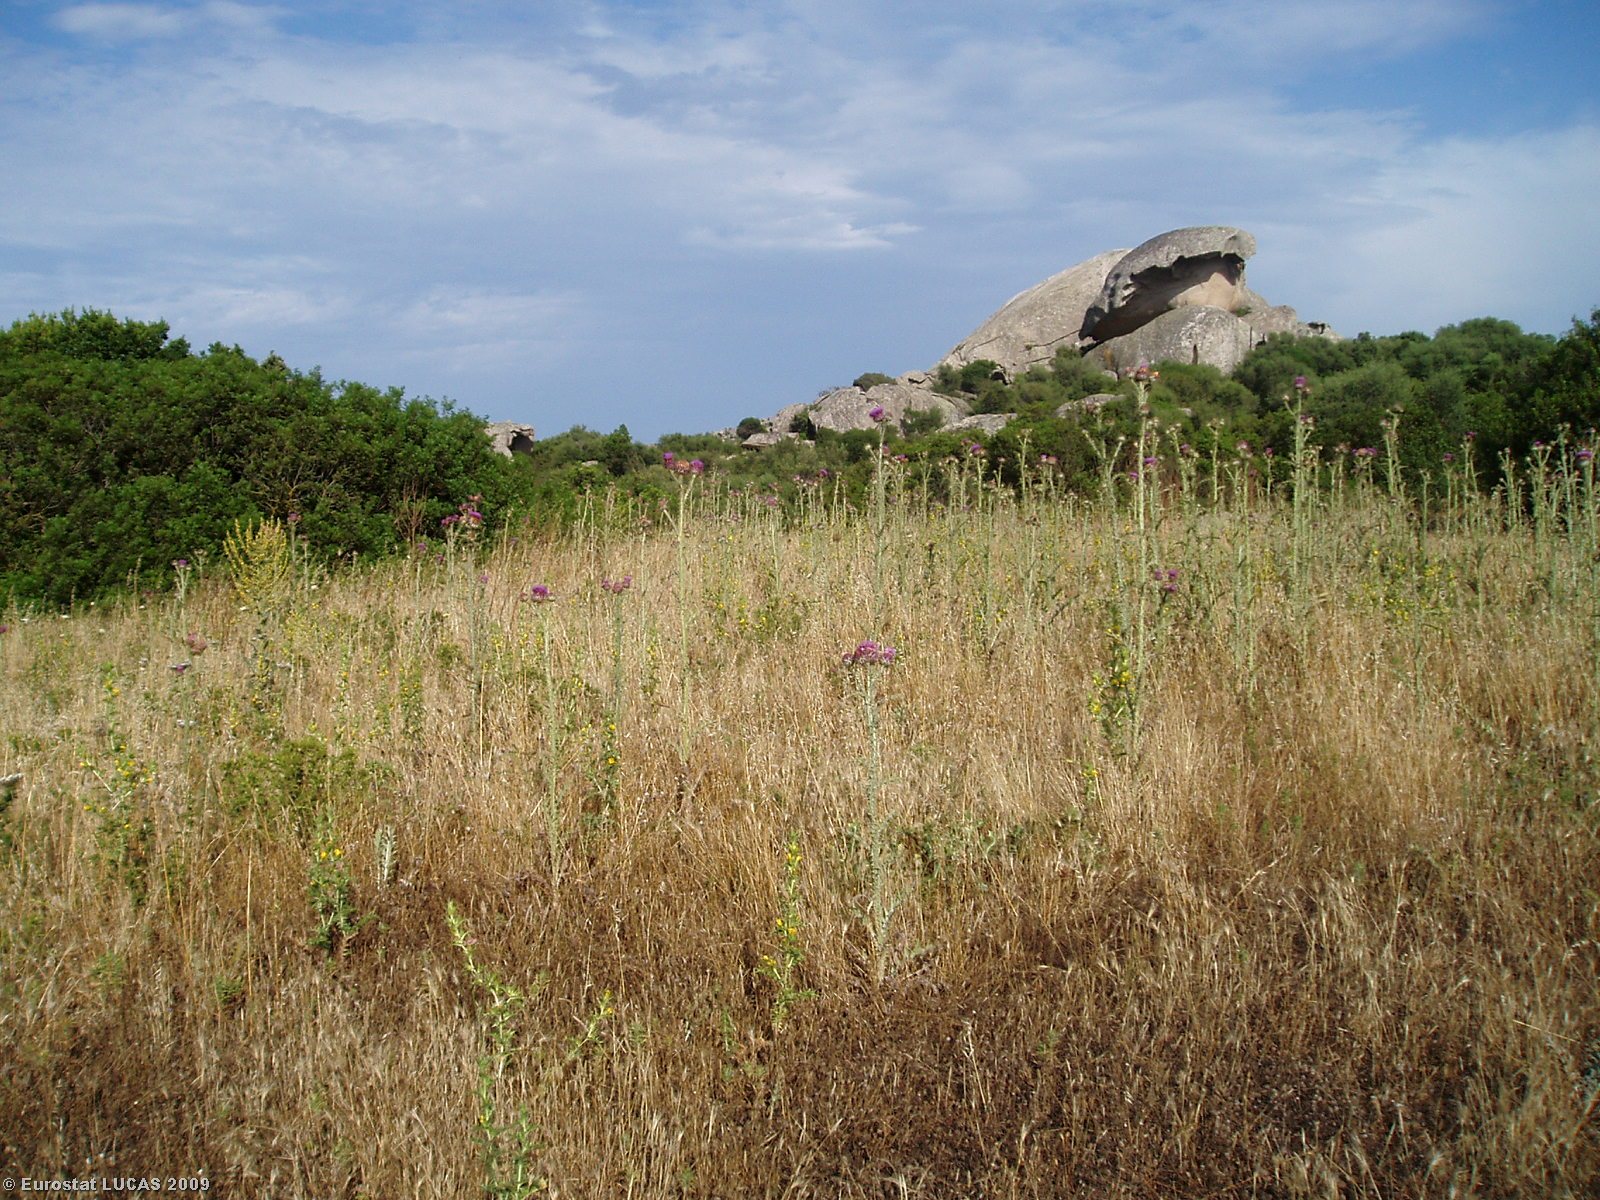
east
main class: Grassland
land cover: Spontaneously vegetated surfaces
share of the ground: > 75 %
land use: Fallow land
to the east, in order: Spontaneously vegetated surfaces; Tracks; Single bushes/trees; Spontaneously vegetated surfaces; Tracks; Shrubland with sparse tree cover; Rock outcrops; Shrubland with sparse tree cover; Spontaneously vegetated surfaces; Electric lines; Abandoned hedges; Ditches and canals; Paved roads, cycling and walking lanes
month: June
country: IT
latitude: 41.0972
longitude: 9.3007
